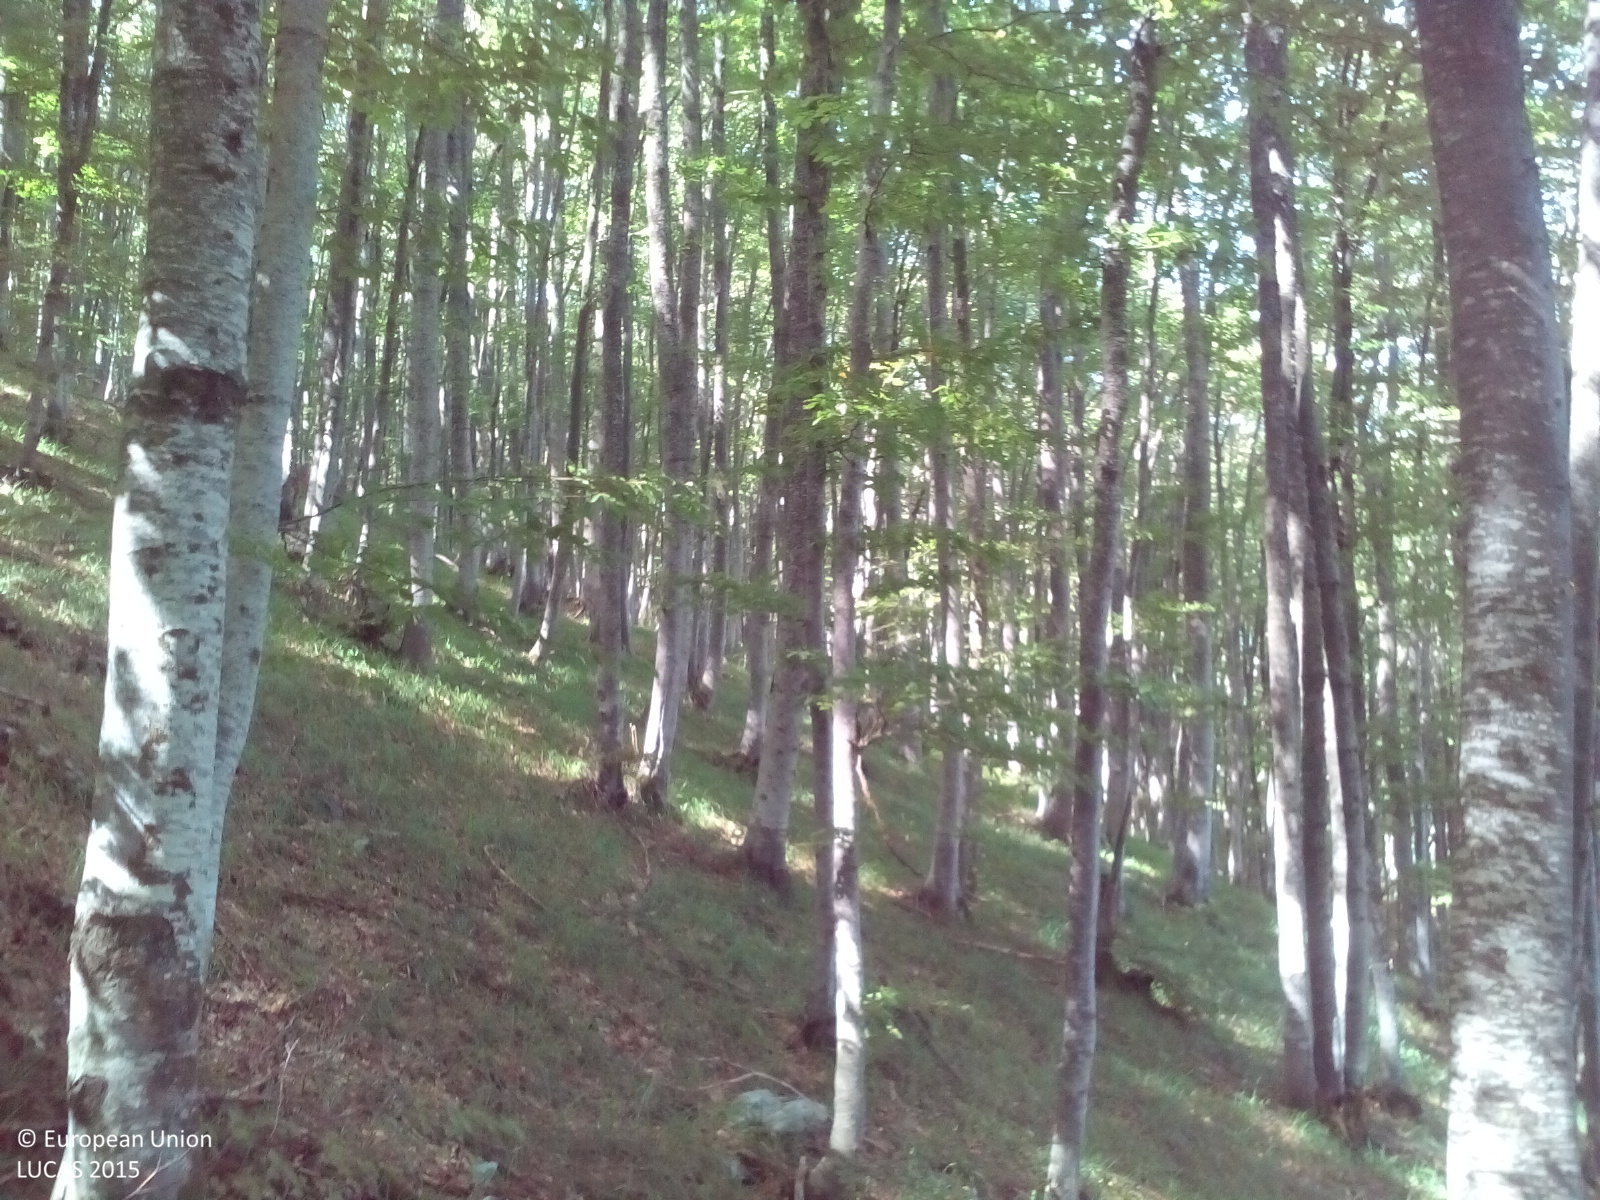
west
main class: Woodland
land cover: Broadleaved woodland
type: mountainous beech forest
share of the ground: > 75 %
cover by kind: broadleaved forest trees 85 %, herbaceous plants 15 %
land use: Forestry
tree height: > 5 m
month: September
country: GR
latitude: 40.7022
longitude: 21.3425
